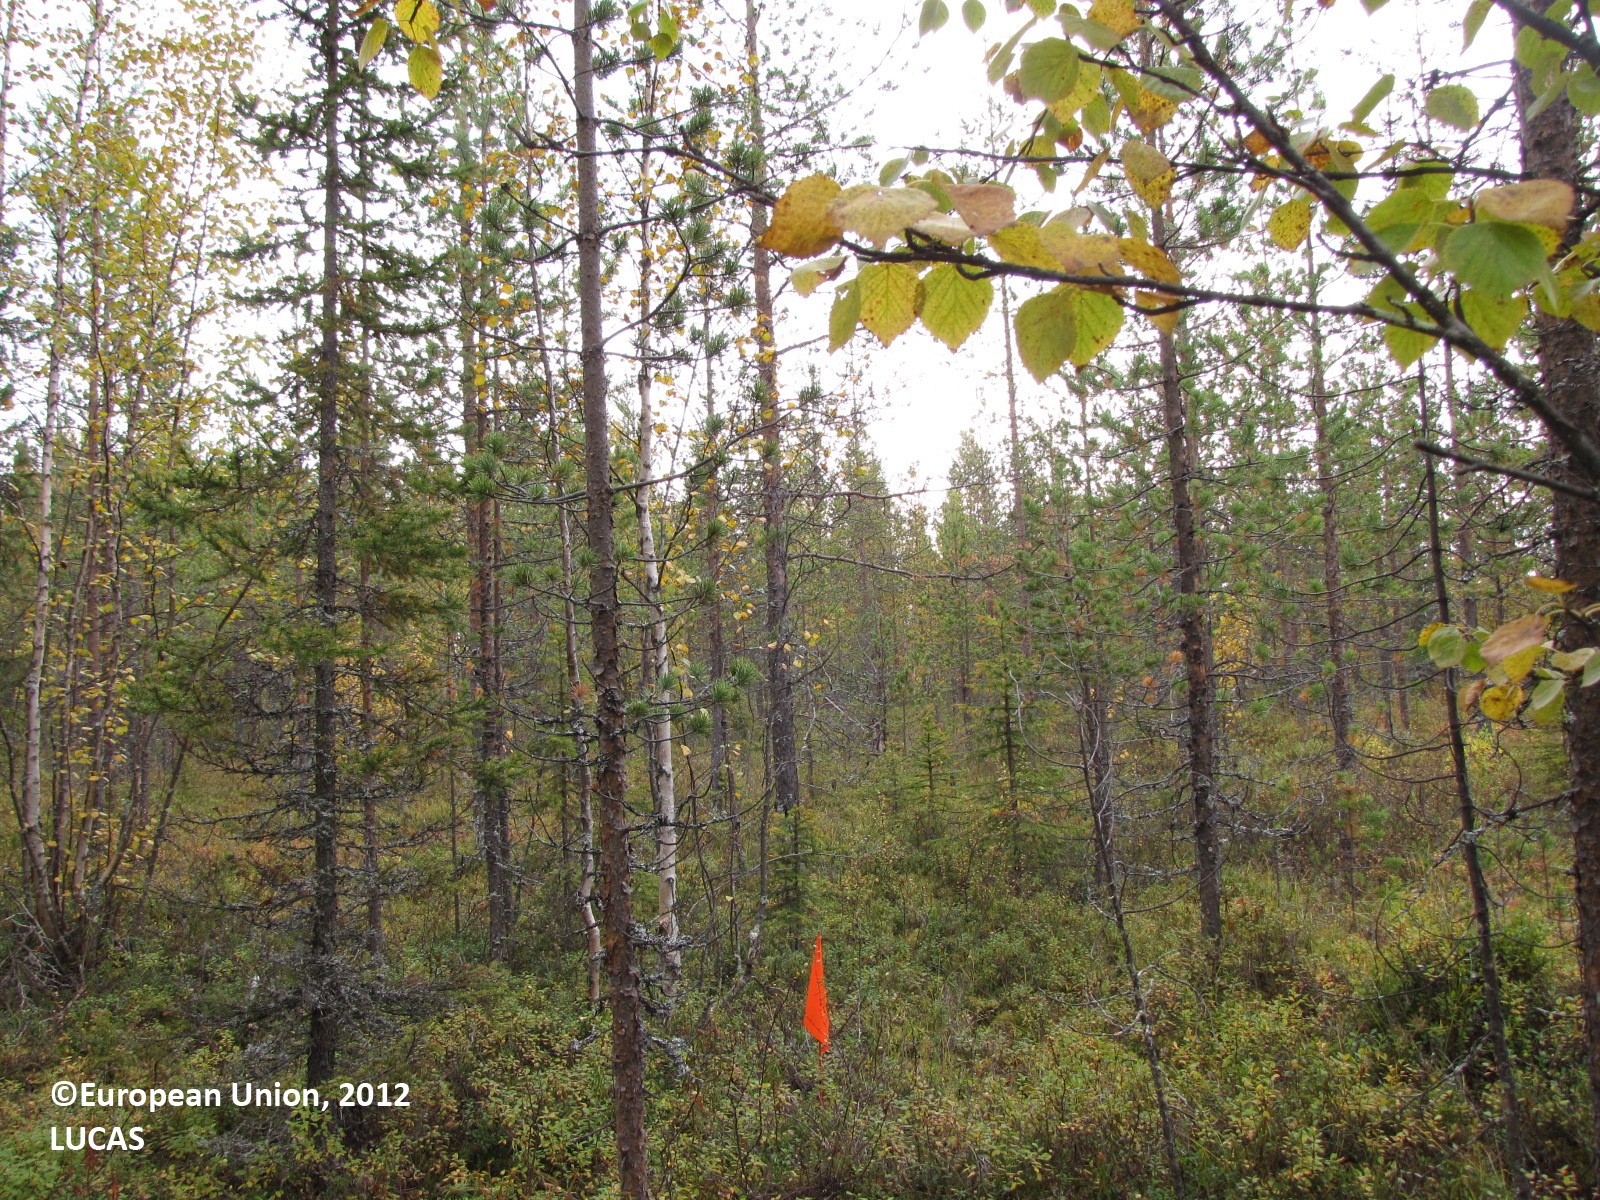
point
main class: Woodland
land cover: Pine dominated mixed woodland
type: boreal forest
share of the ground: 25 - 50 %
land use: Forestry
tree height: > 5 m
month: September
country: FI
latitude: 67.3572
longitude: 23.9198
